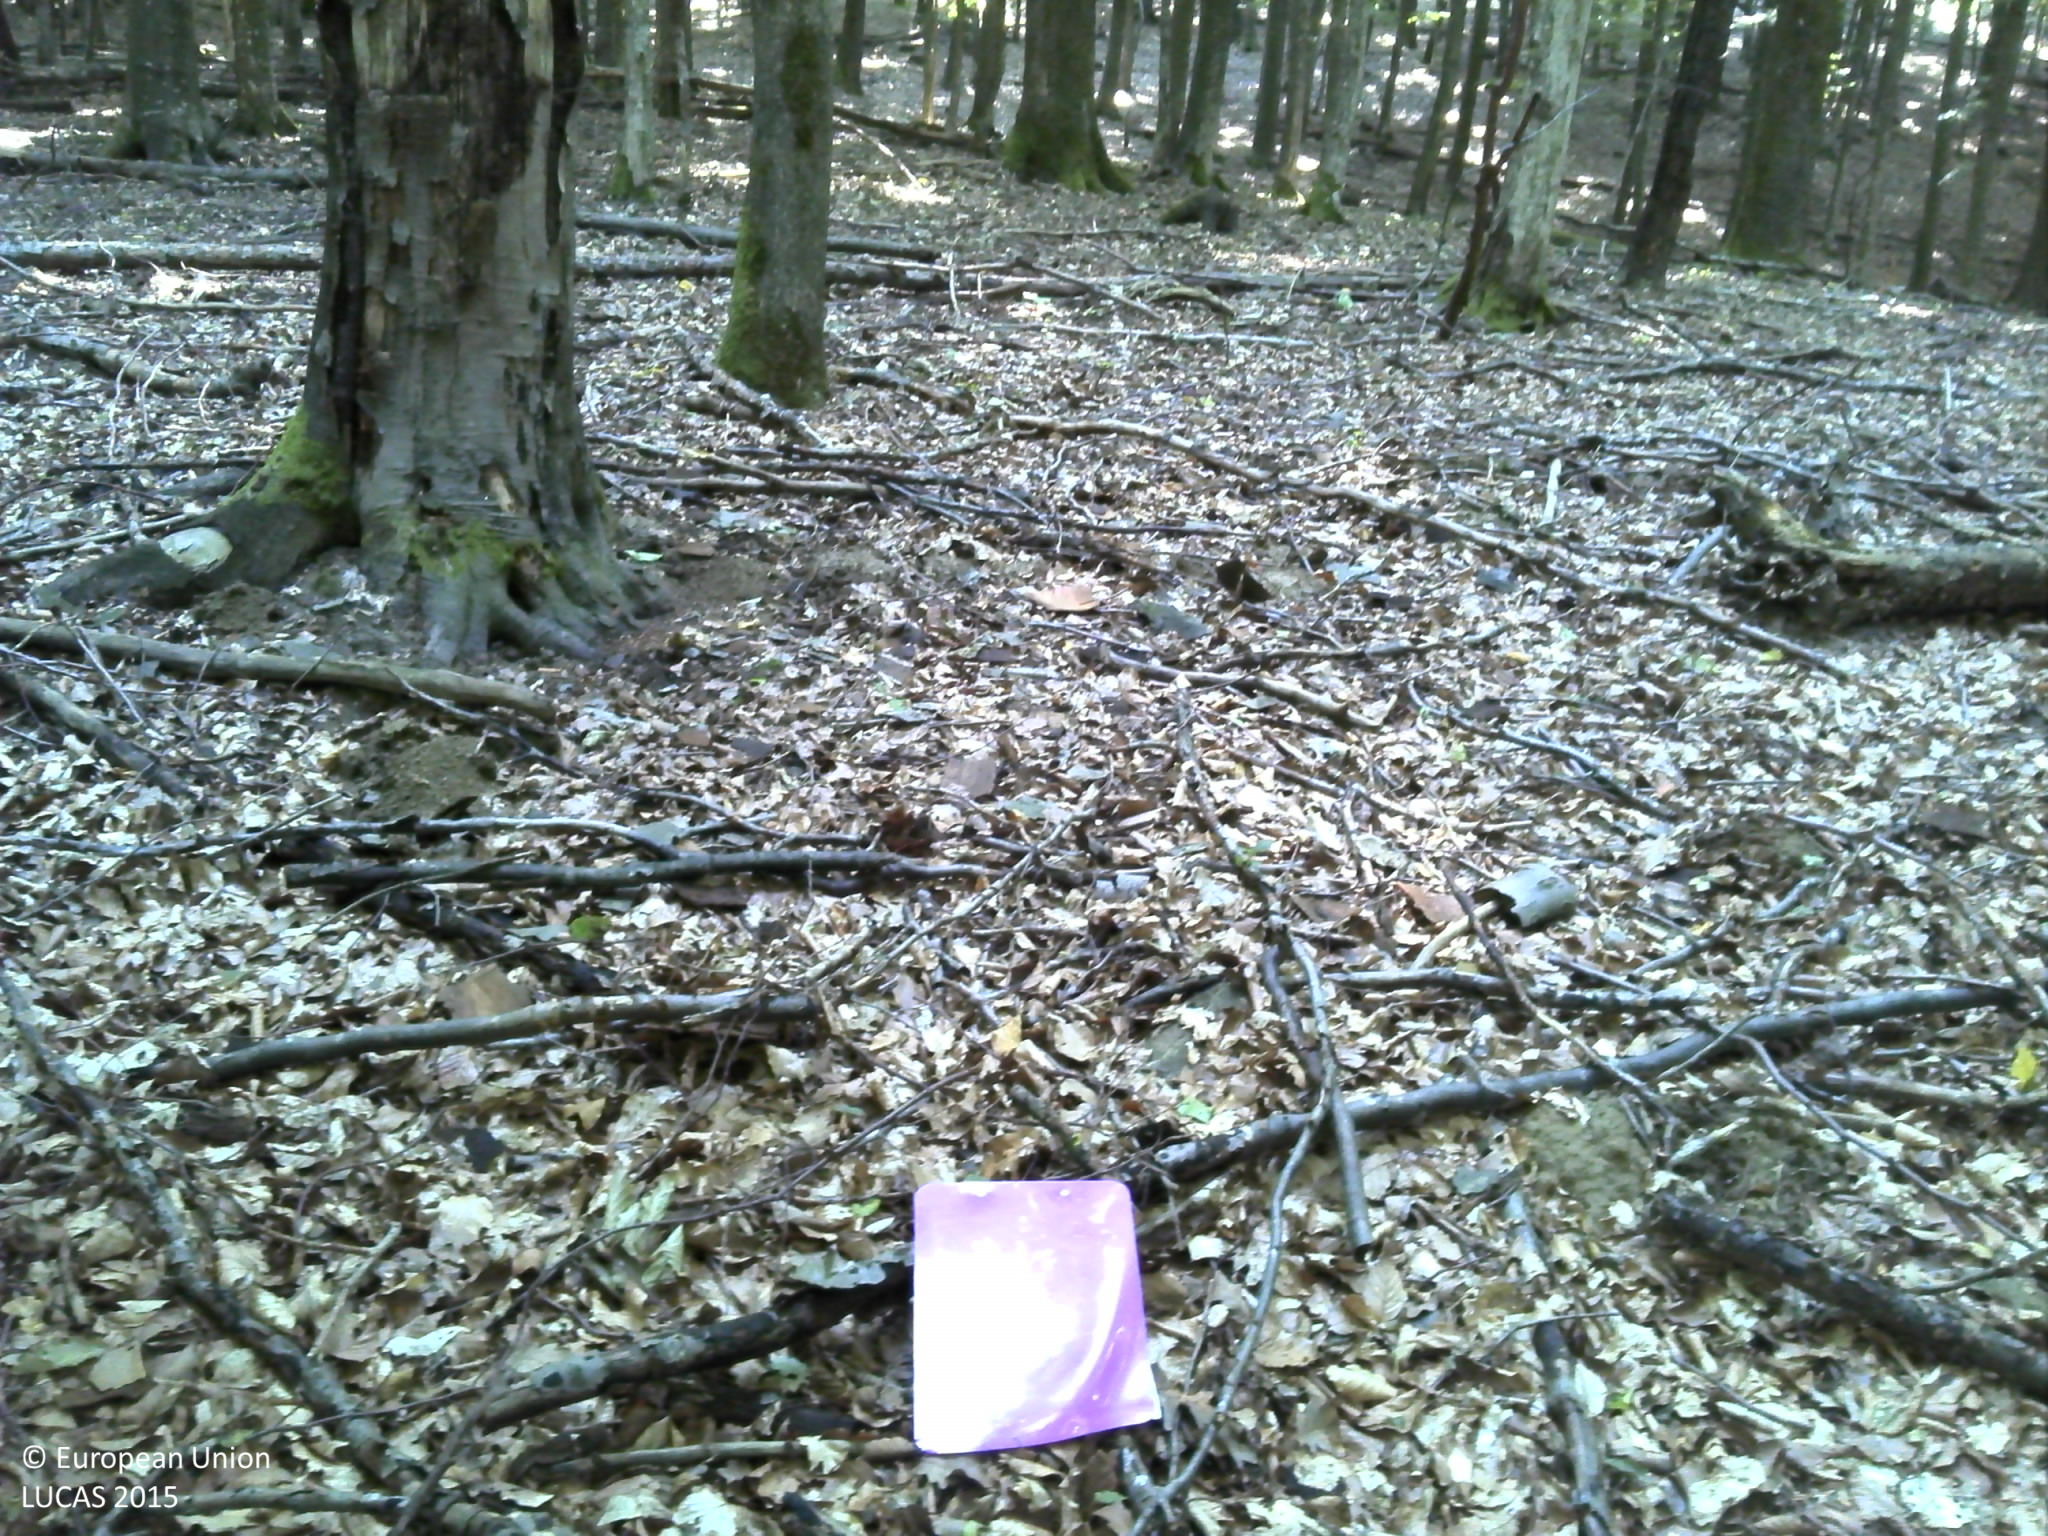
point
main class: Woodland
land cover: Broadleaved woodland
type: acidophilous oak and oak-birch forest
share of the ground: > 75 %
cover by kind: broadleaved forest trees 80 %, lichens and mosses 20 %
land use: Forestry
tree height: > 5 m
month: July
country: HR
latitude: 45.5790
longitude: 16.7273
